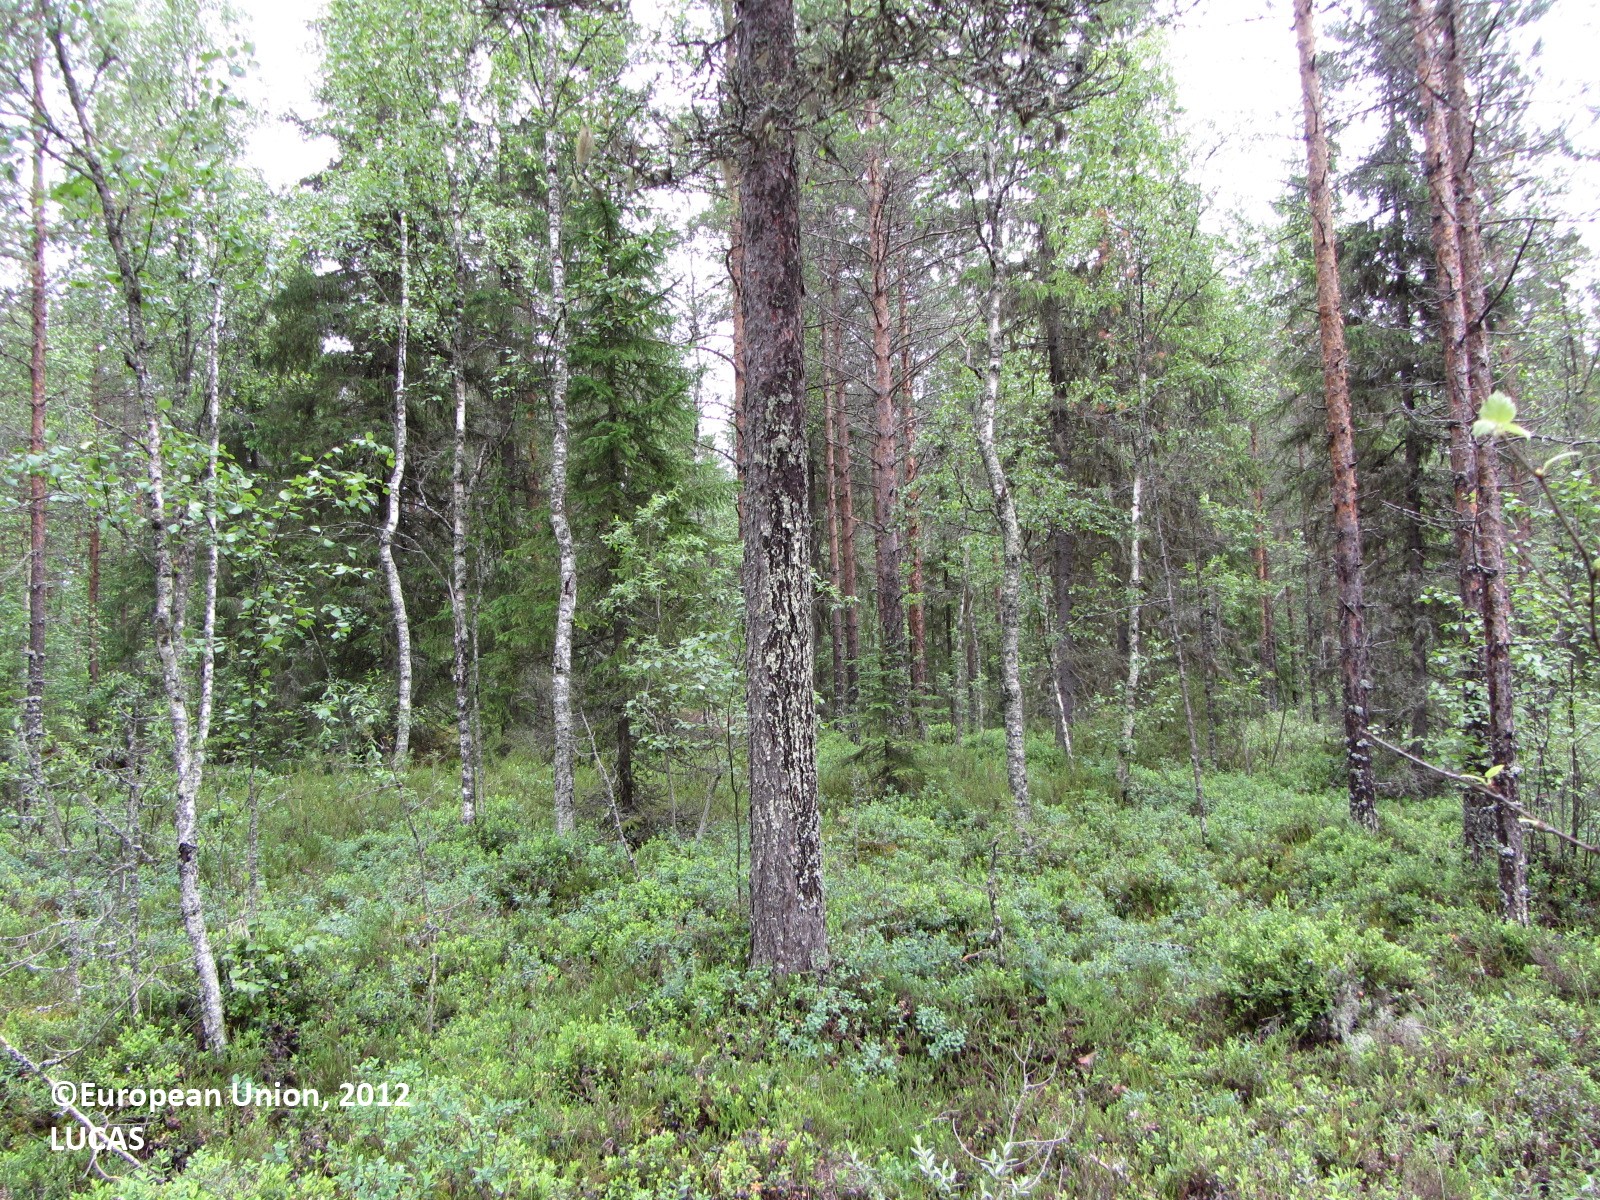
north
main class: Woodland
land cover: Pine dominated coniferous woodland
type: boreal forest
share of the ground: 50 - 75 %
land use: Forestry
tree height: > 5 m
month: July
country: FI
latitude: 63.8577
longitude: 25.6216
